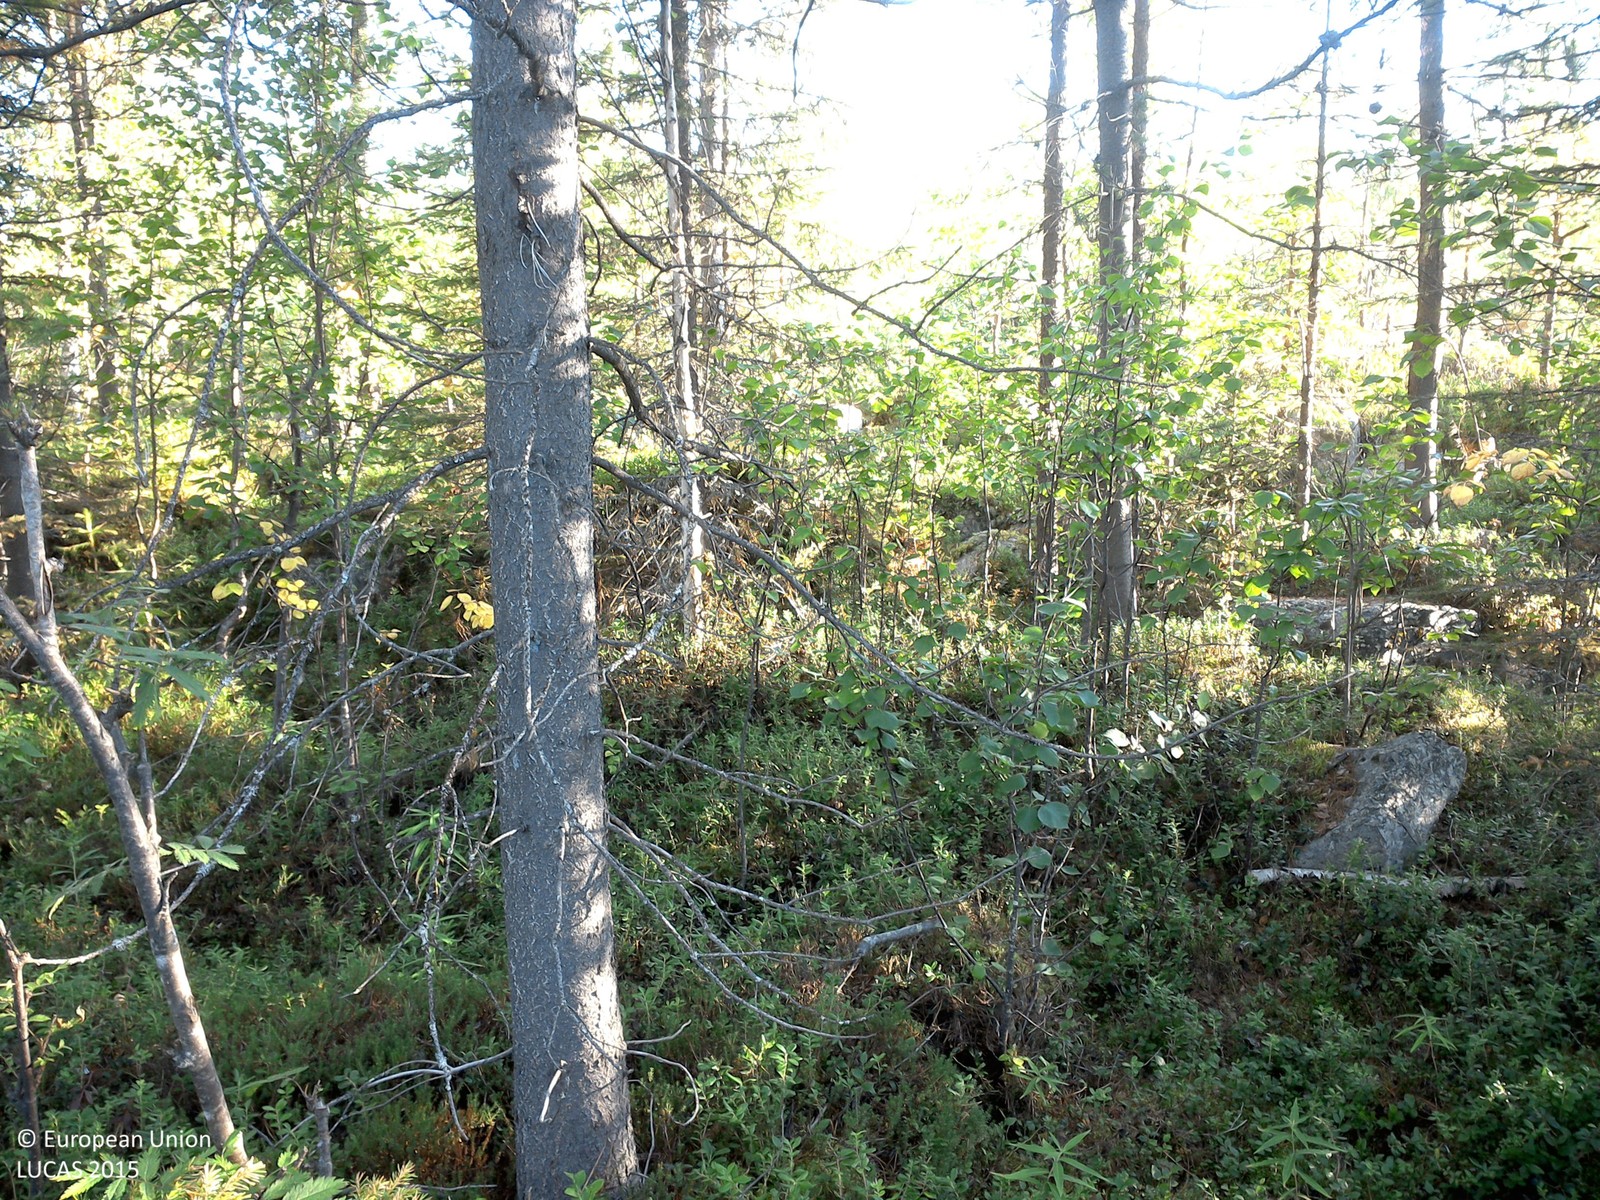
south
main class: Woodland
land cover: Pine dominated coniferous woodland
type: exotic forest
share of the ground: 50 - 75 %
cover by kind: coniferous forest trees 45 %, shrubs 45 %, broadleaved forest trees 5 %, lichens and mosses 5 %
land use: Forestry
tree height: > 5 m
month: August
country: SE
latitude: 67.0635
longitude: 21.6608
